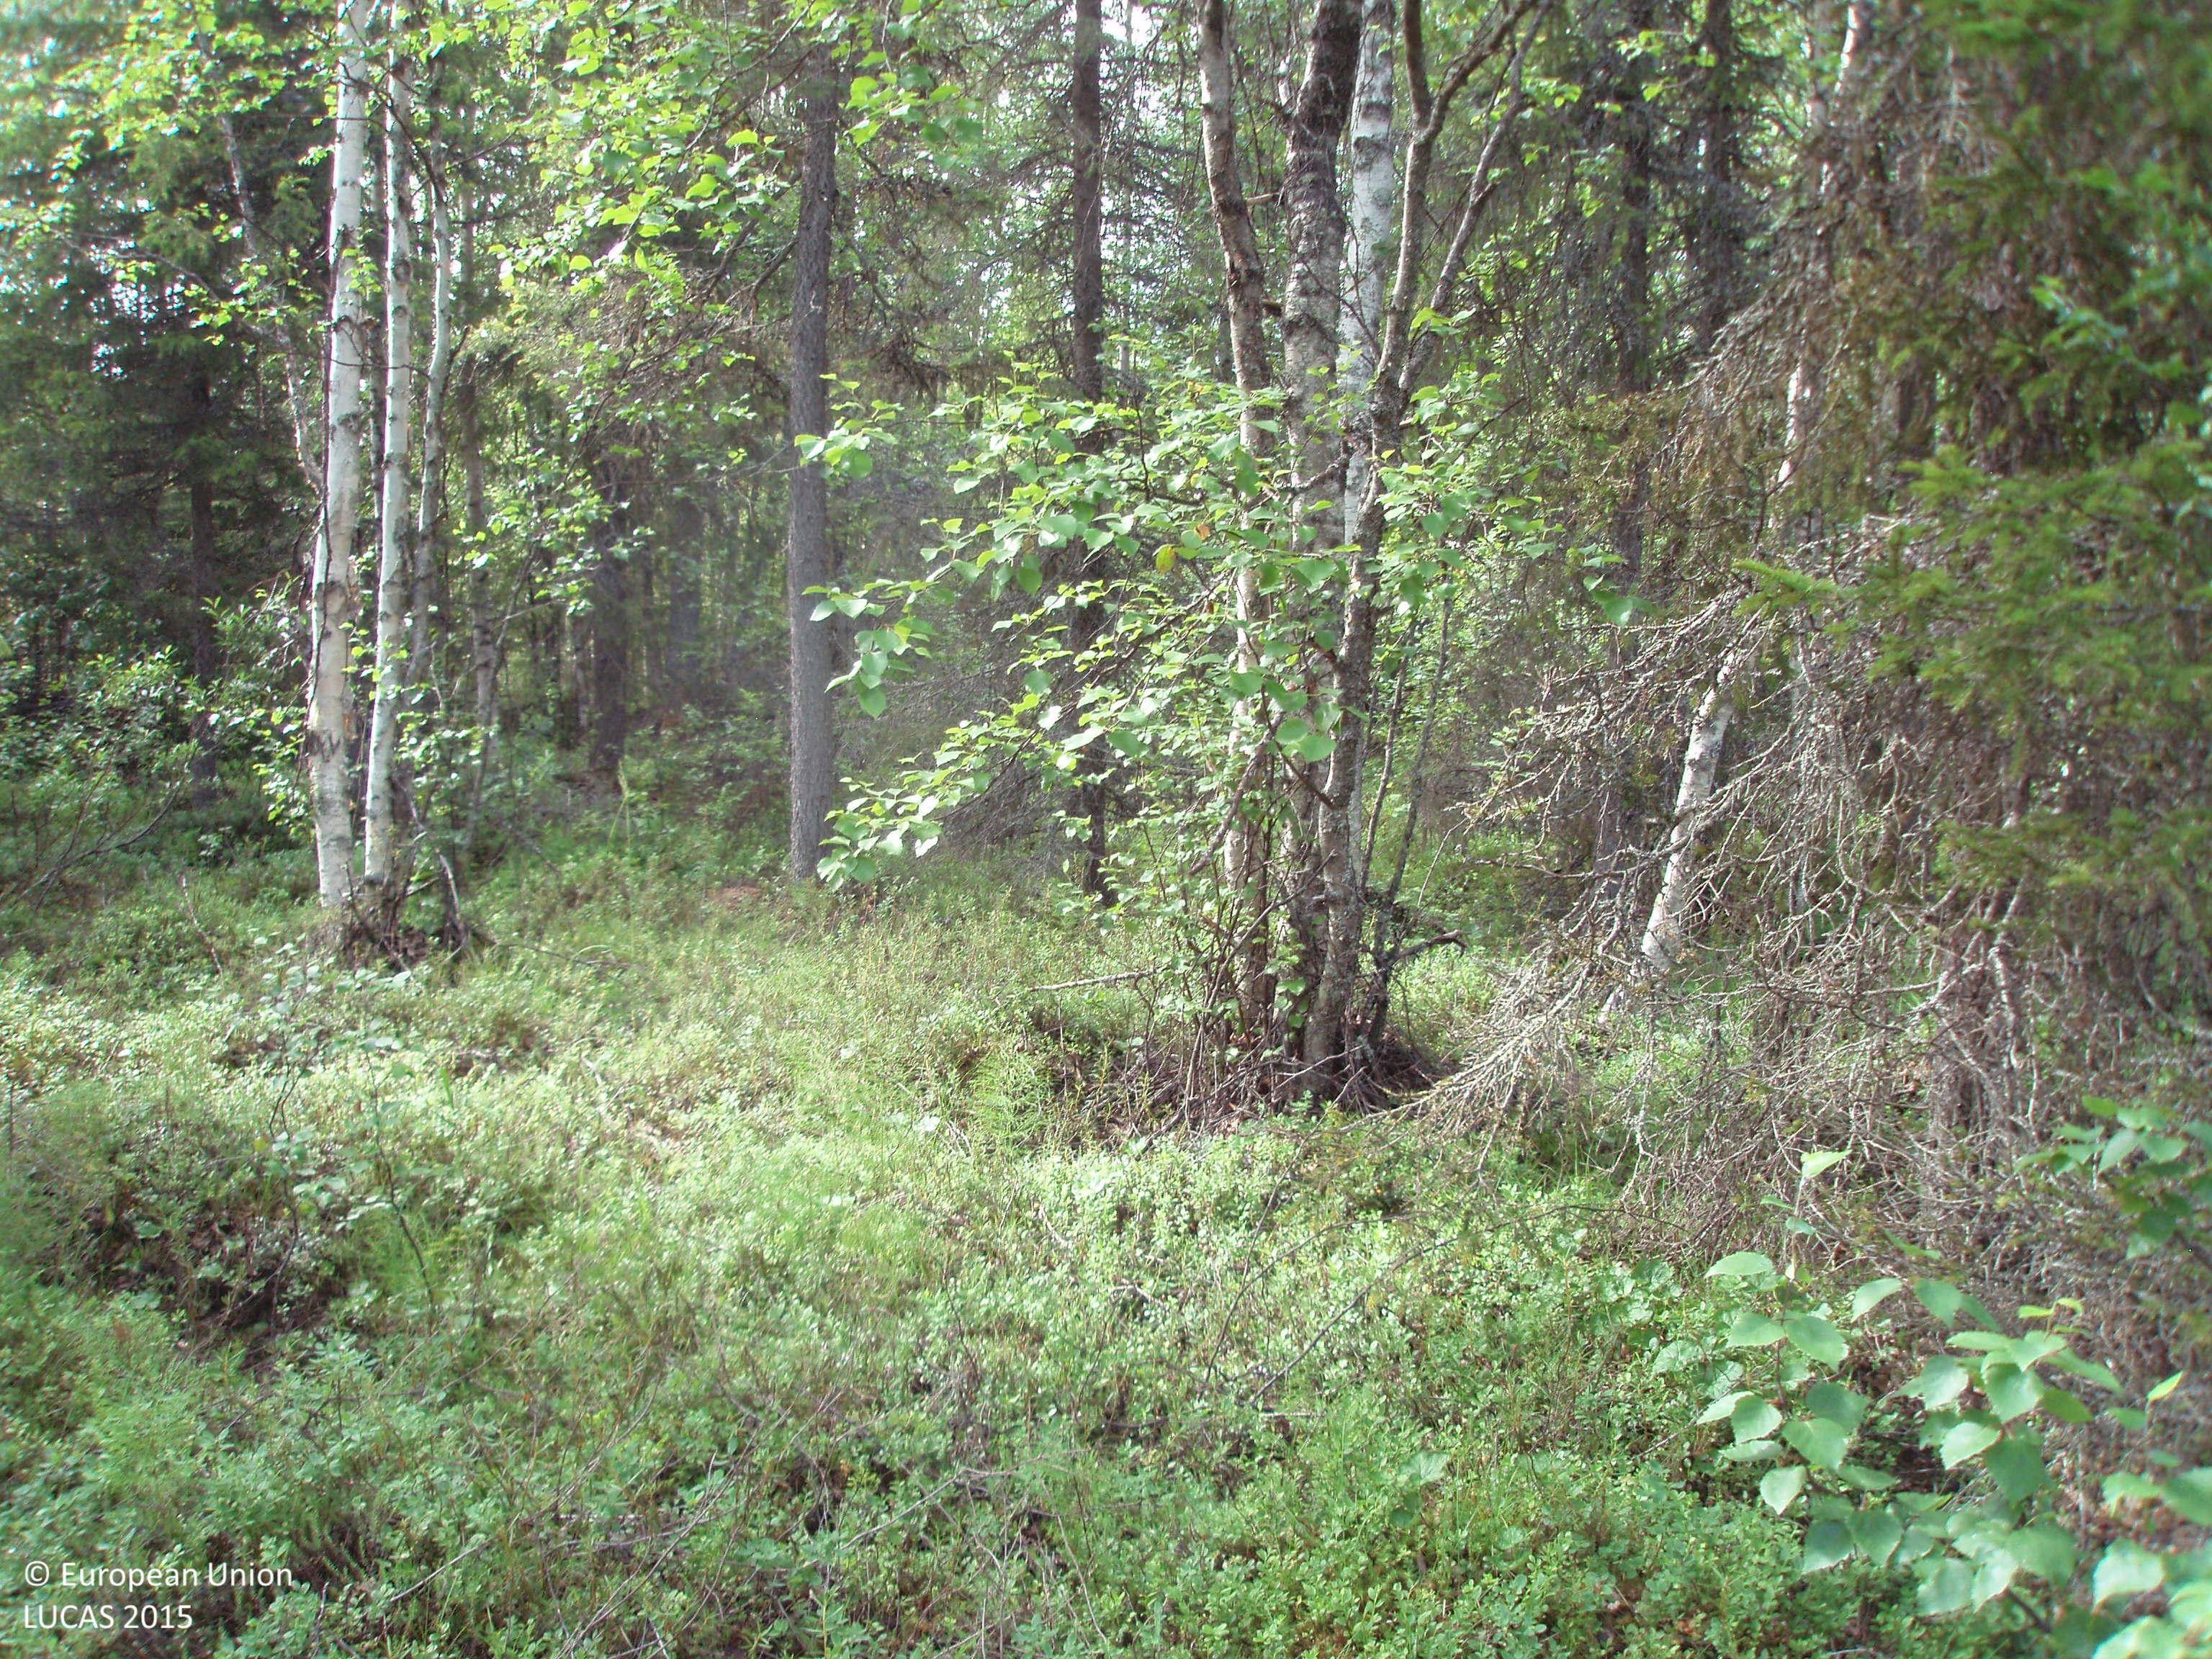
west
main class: Woodland
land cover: Other mixed woodland
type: boreal forest
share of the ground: > 75 %
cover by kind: coniferous forest trees 45 %, broadleaved forest trees 40 %, shrubs 15 %
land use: Forestry
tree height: > 5 m
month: July
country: FI
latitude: 66.9322
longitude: 28.5987
